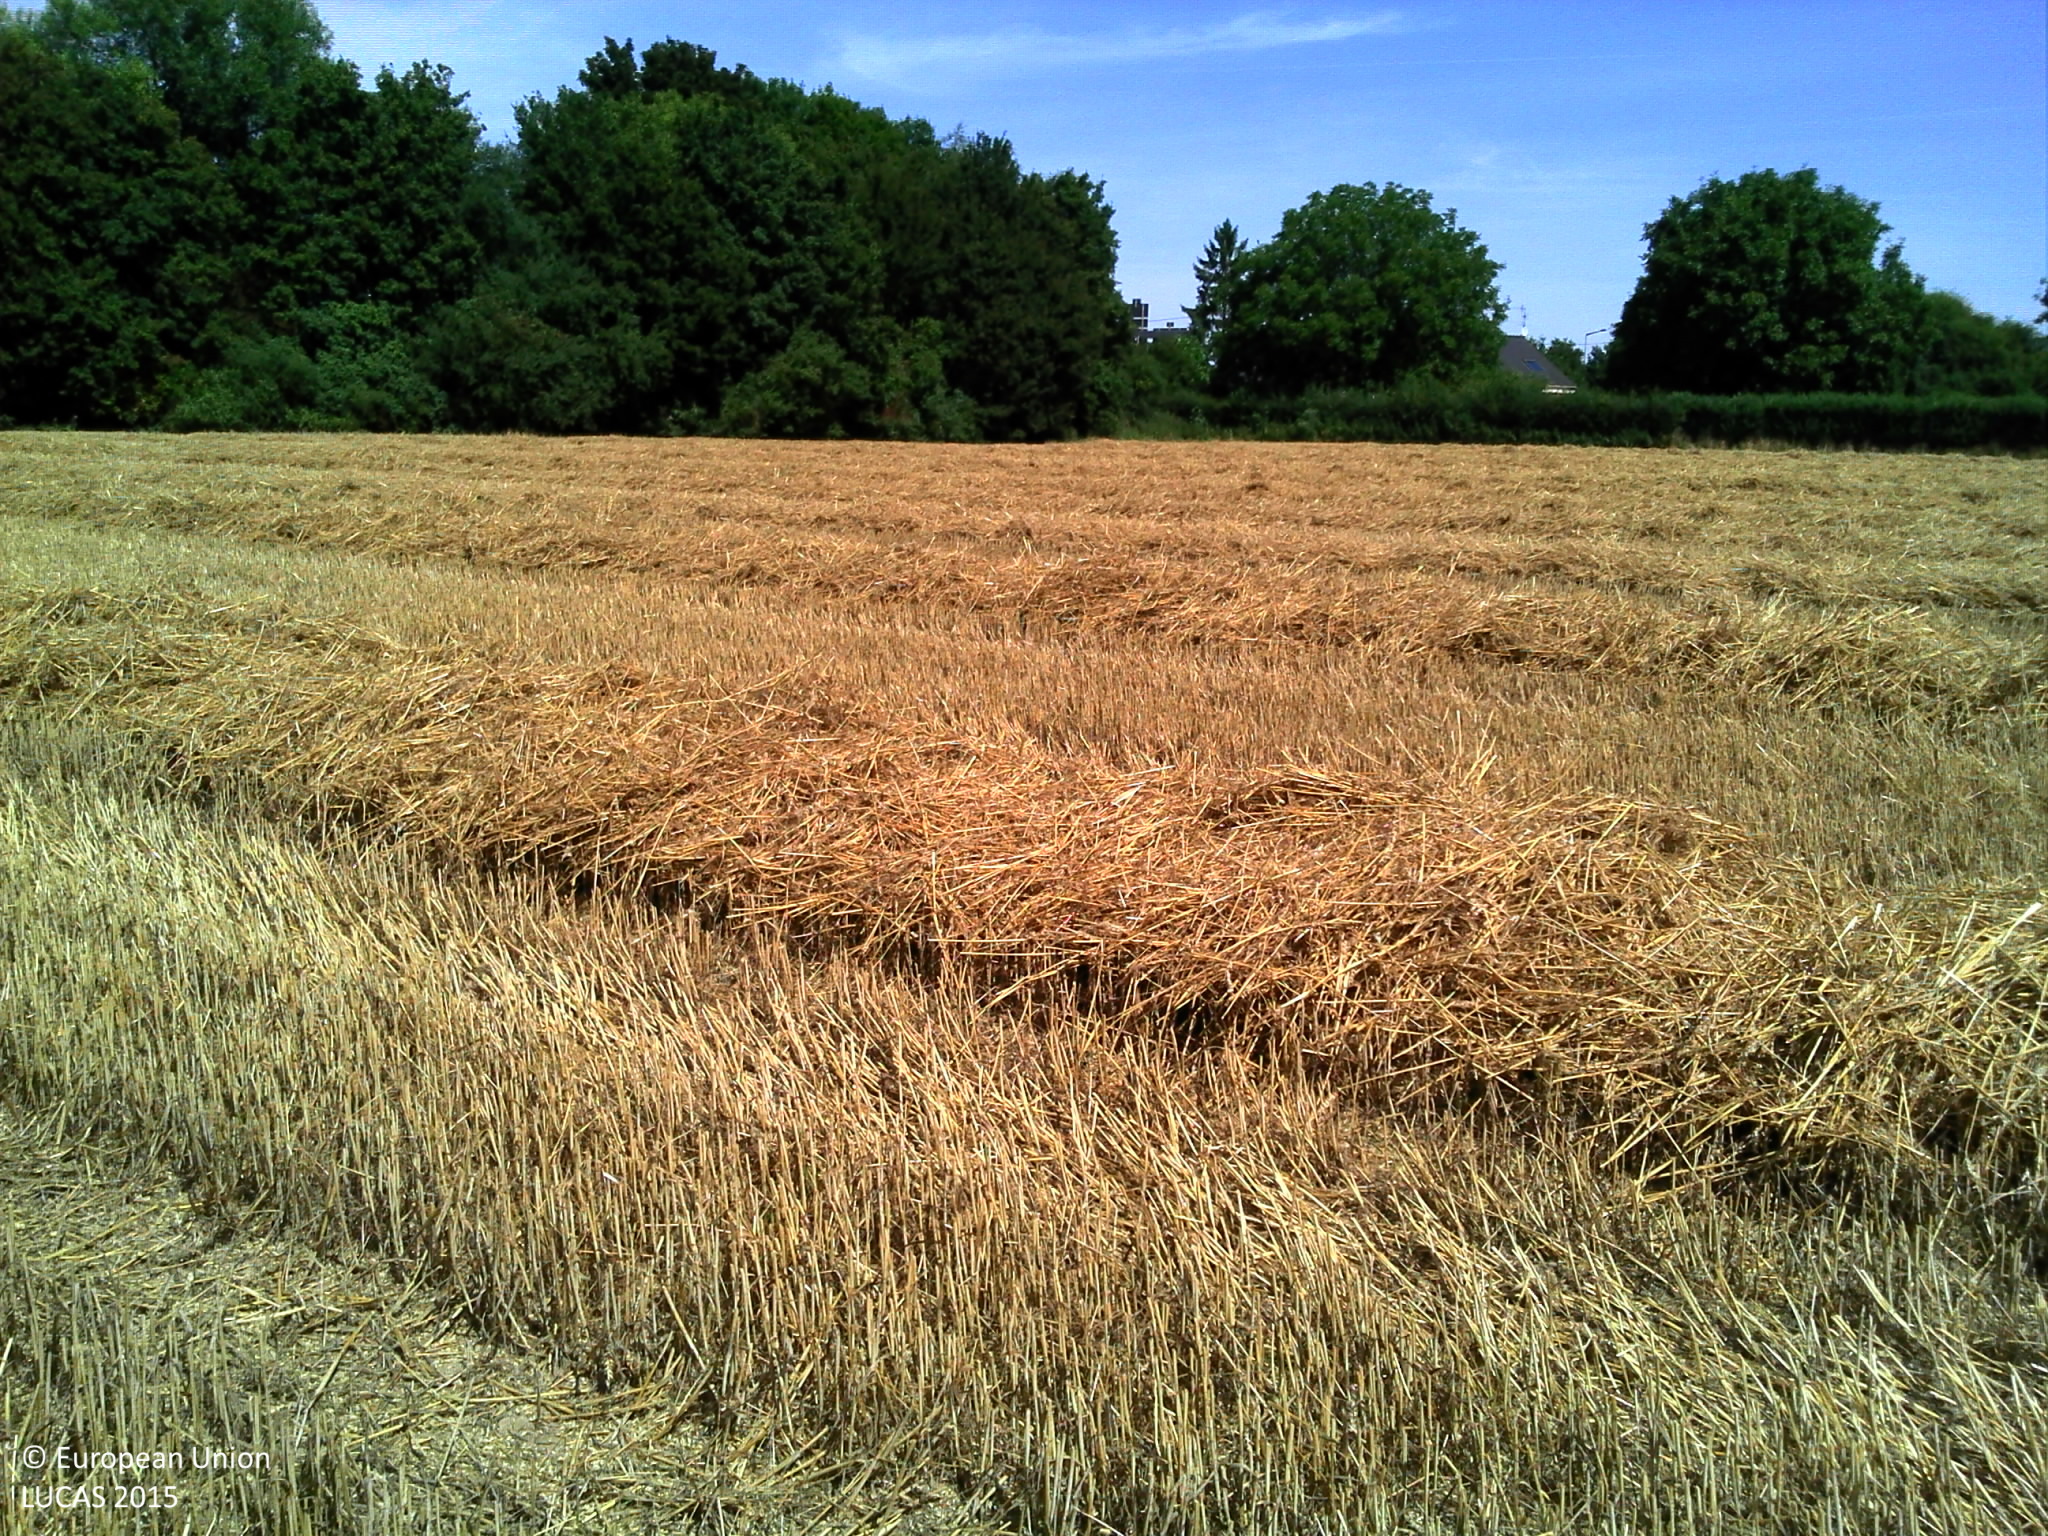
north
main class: Cropland
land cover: Common wheat
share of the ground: 10 - 25 %
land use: Agriculture (excluding fallow land and kitchen gardens)
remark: Harvested field
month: August
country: FR
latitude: 50.3356
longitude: 3.0922
